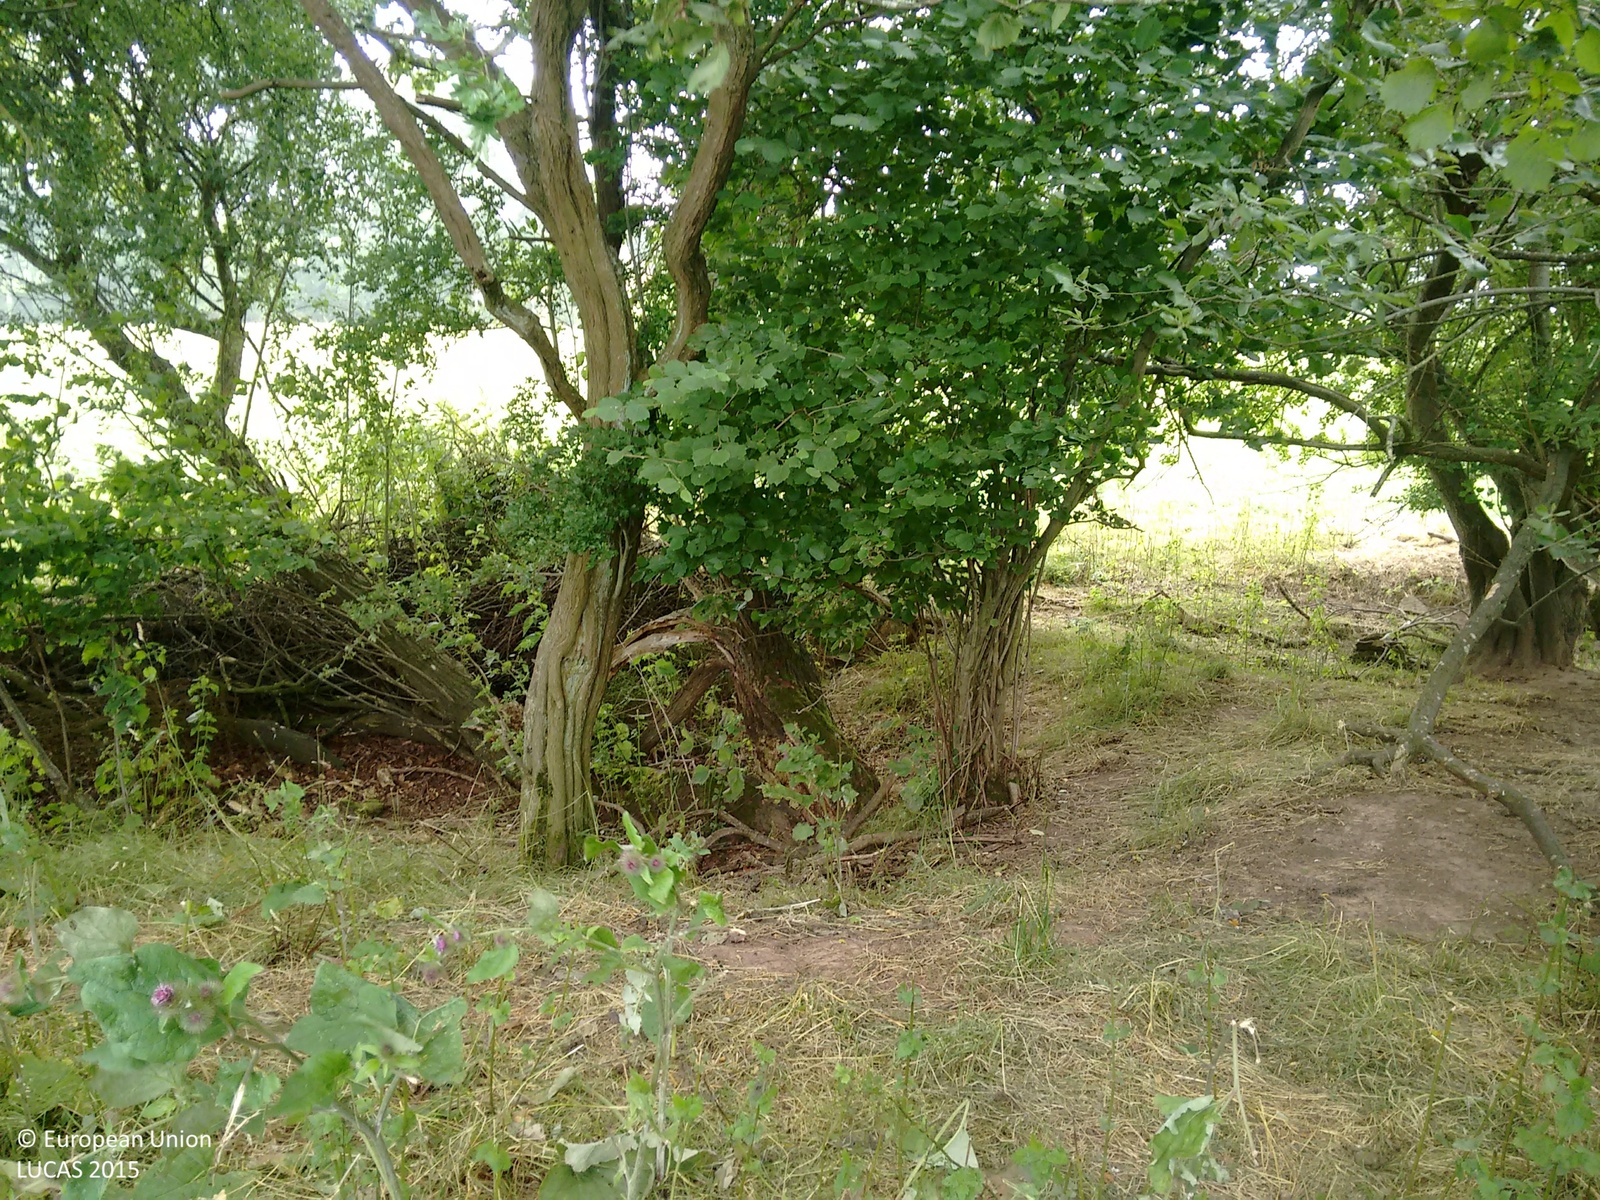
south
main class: Grassland
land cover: Grassland without tree/shrub cover
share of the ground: > 75 %
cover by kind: herbaceous plants 100 %
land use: Agriculture (excluding fallow land and kitchen gardens)
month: August
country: GB
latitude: 51.9908
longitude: -2.9626
